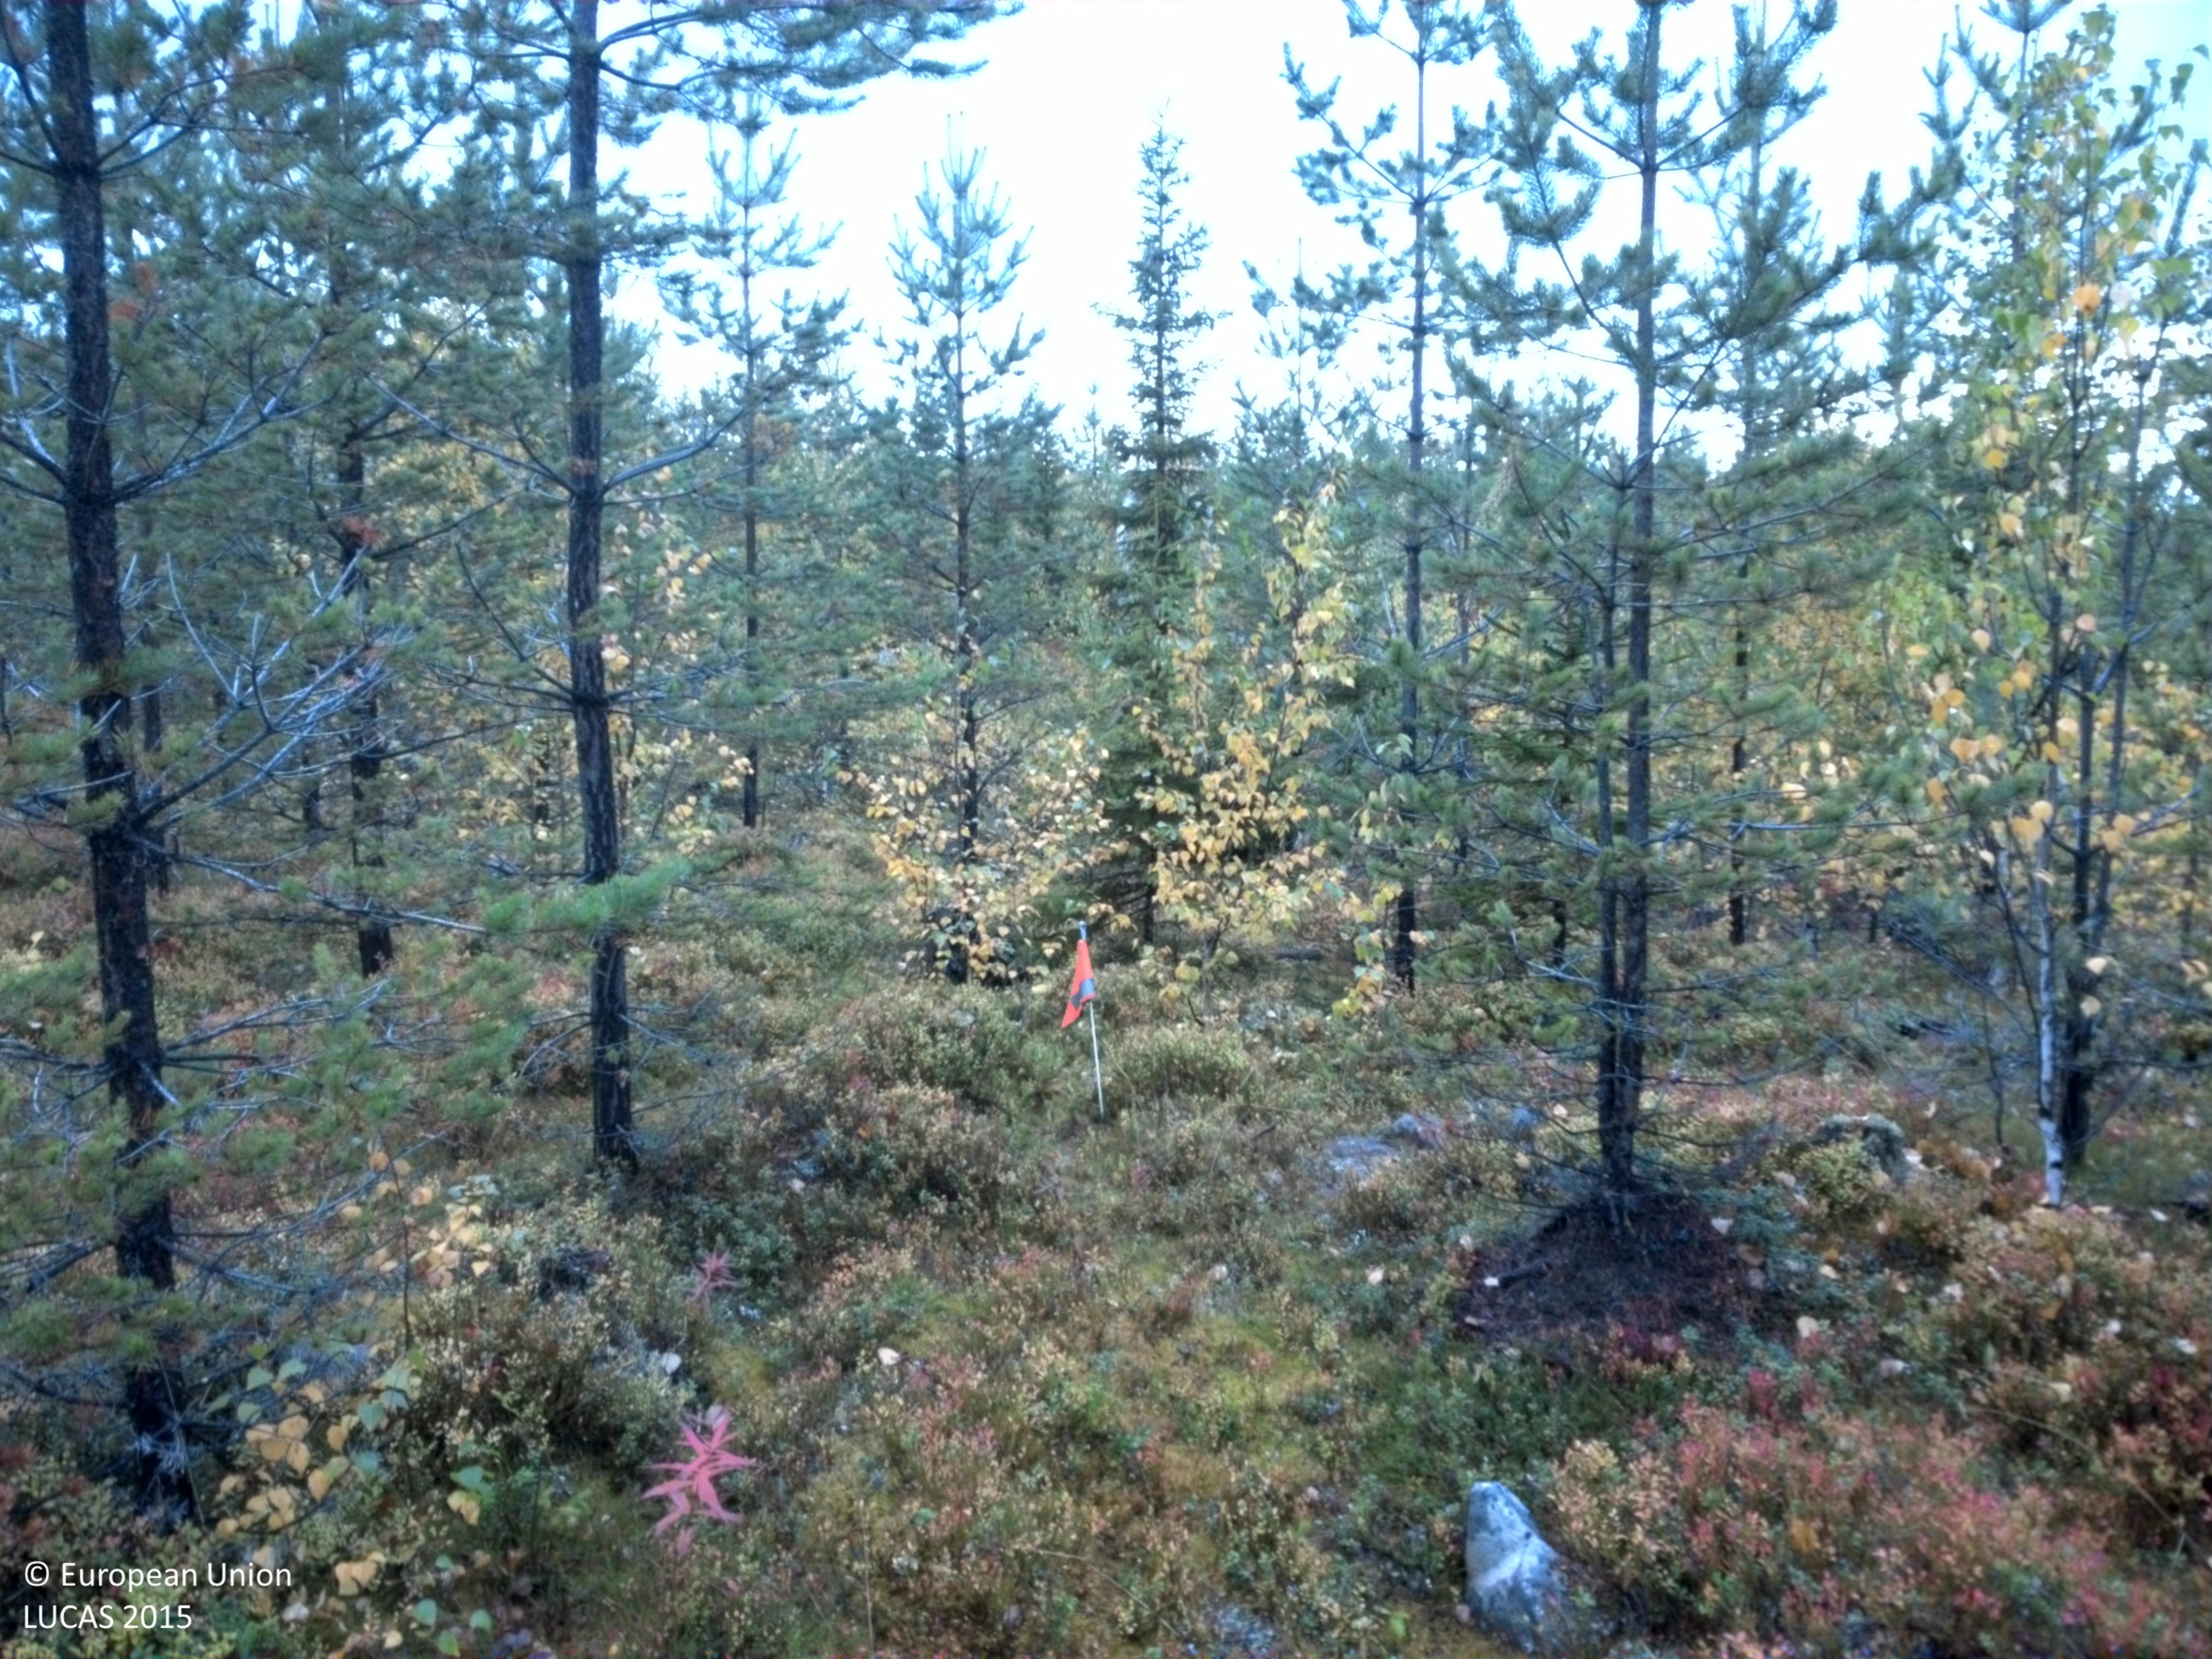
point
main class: Woodland
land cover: Pine dominated mixed woodland
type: boreal forest
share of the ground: 25 - 50 %
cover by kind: coniferous forest trees 30 %, shrubs 30 %, herbaceous plants 15 %, lichens and mosses 15 %, broadleaved forest trees 10 %
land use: Forestry
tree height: > 5 m
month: September
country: SE
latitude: 65.0735
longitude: 17.5121
